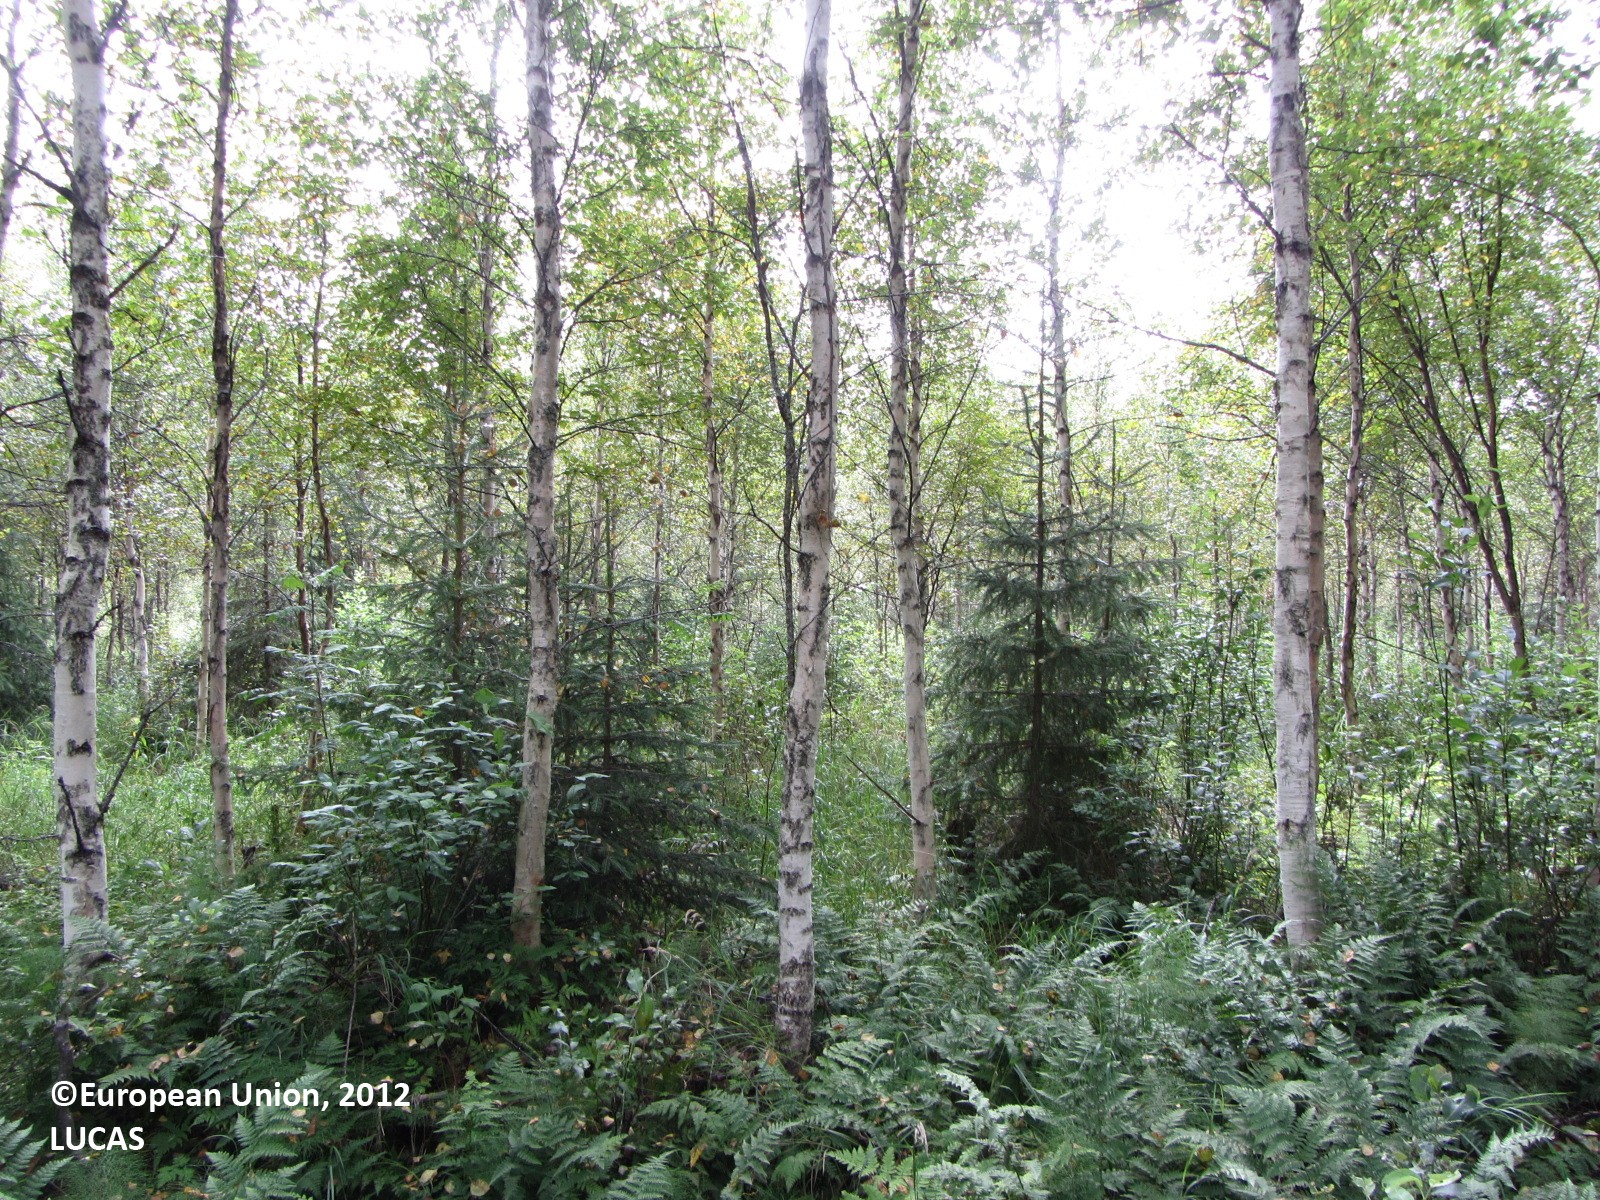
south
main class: Woodland
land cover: Spruce dominated mixed woodland
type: boreal forest
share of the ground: > 75 %
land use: Forestry
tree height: > 5 m
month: August
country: FI
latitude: 63.2523
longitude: 25.2135
